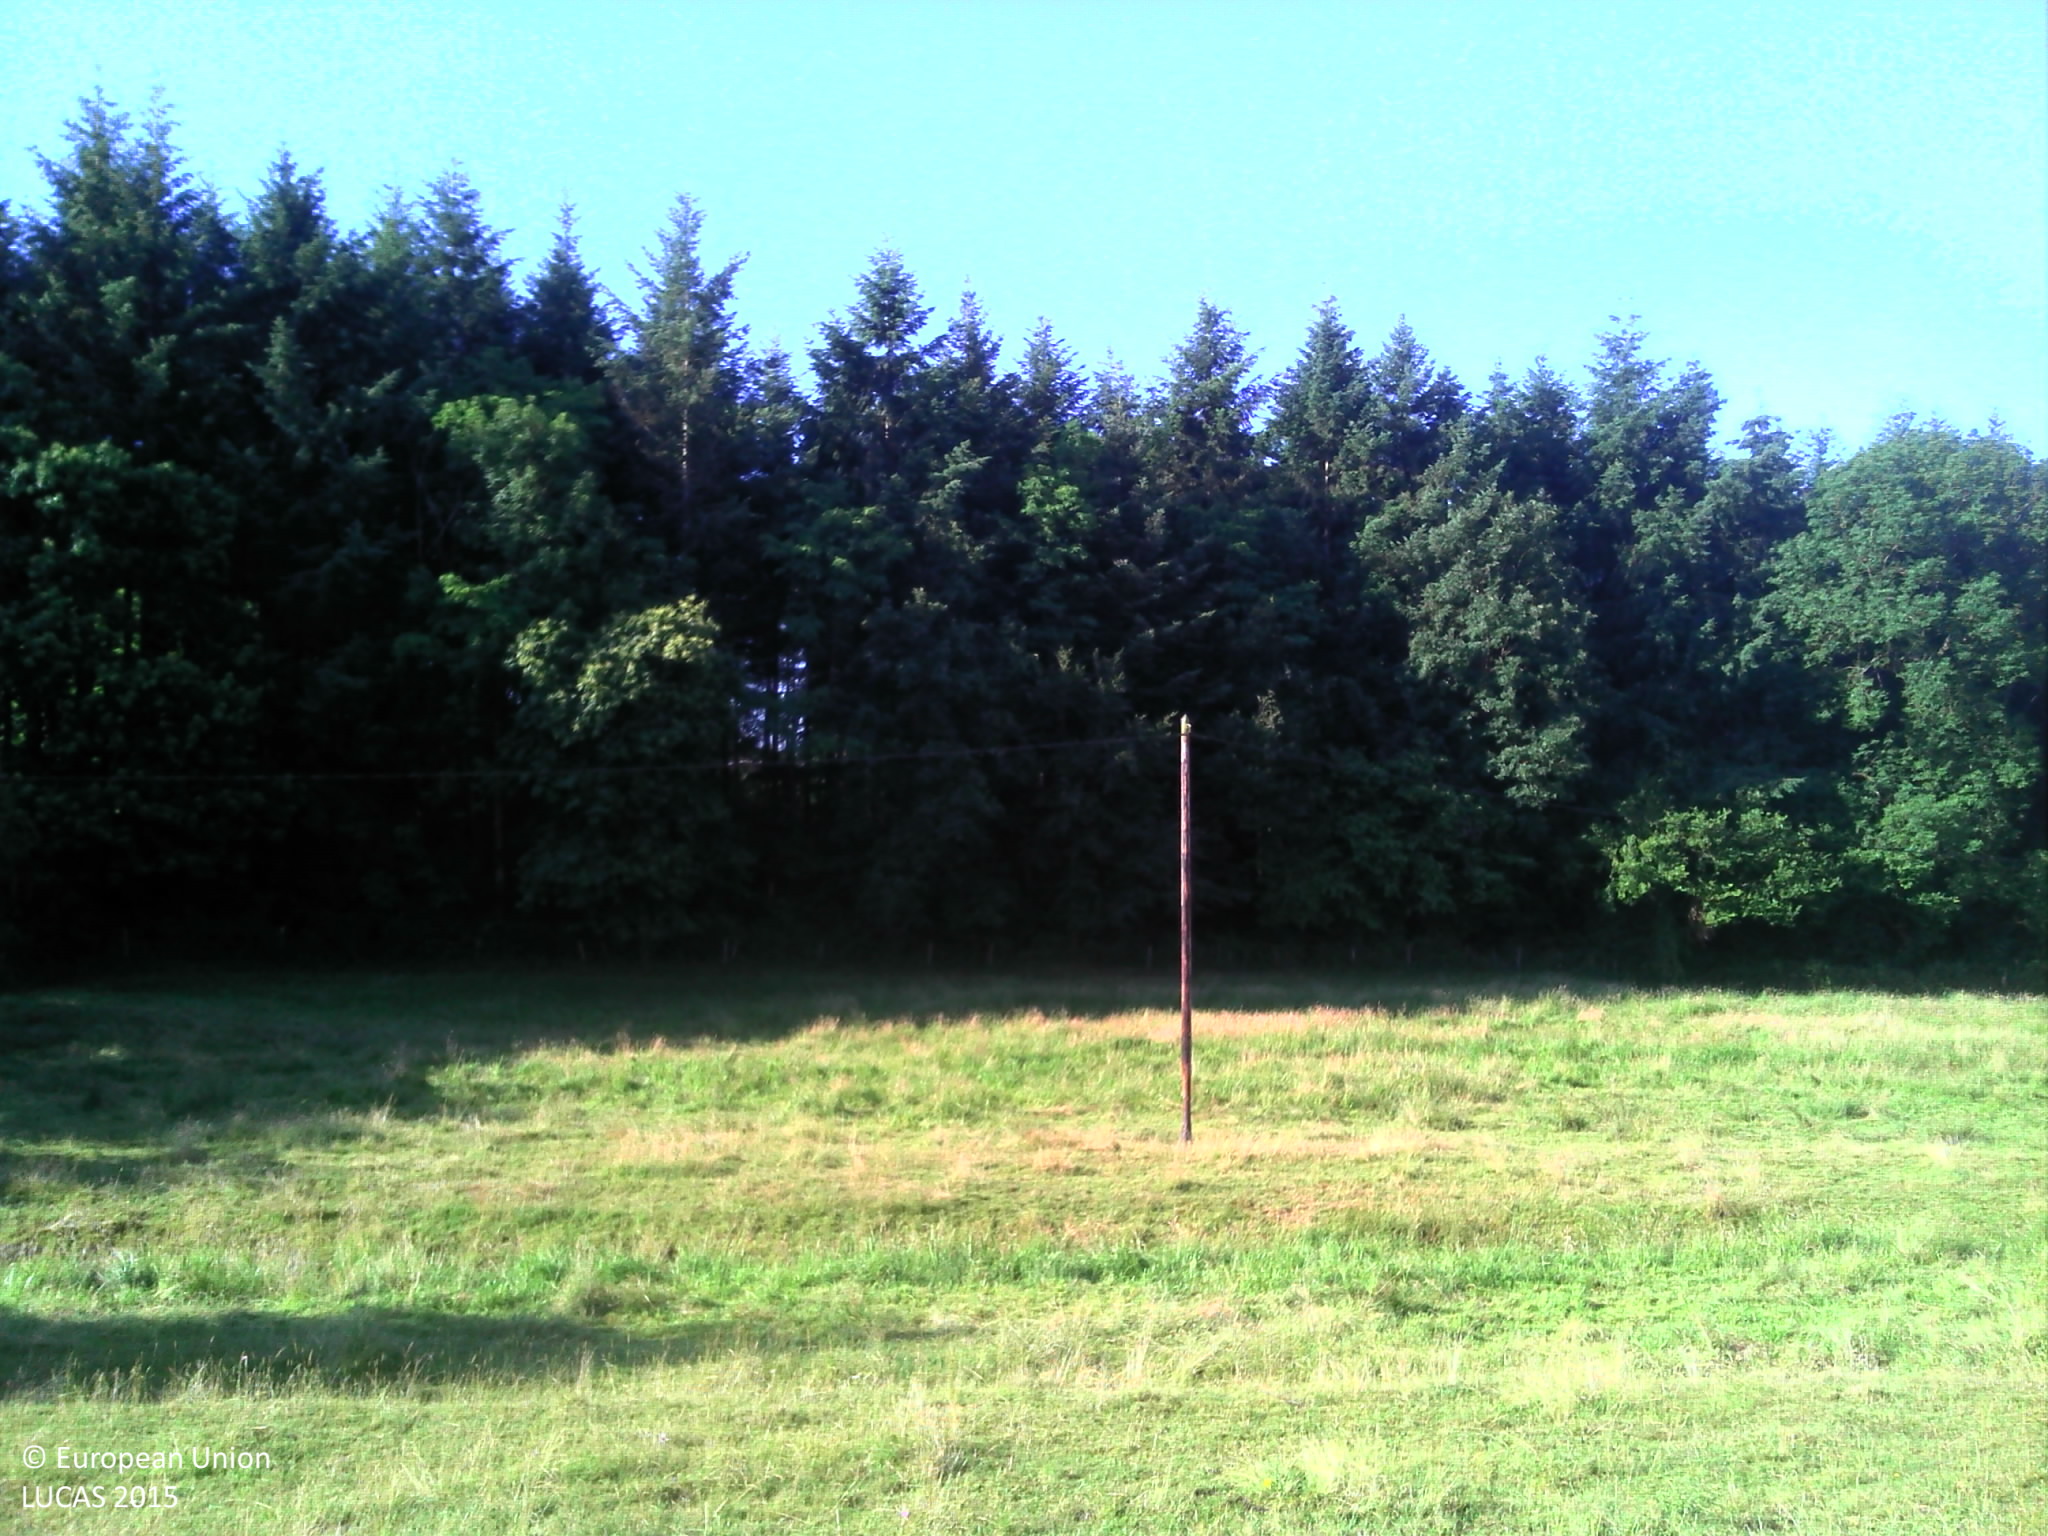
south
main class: Grassland
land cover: Grassland without tree/shrub cover
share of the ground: > 75 %
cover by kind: herbaceous plants 100 %
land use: Agriculture (excluding fallow land and kitchen gardens)
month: June
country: FR
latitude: 46.4967
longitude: 4.4637
